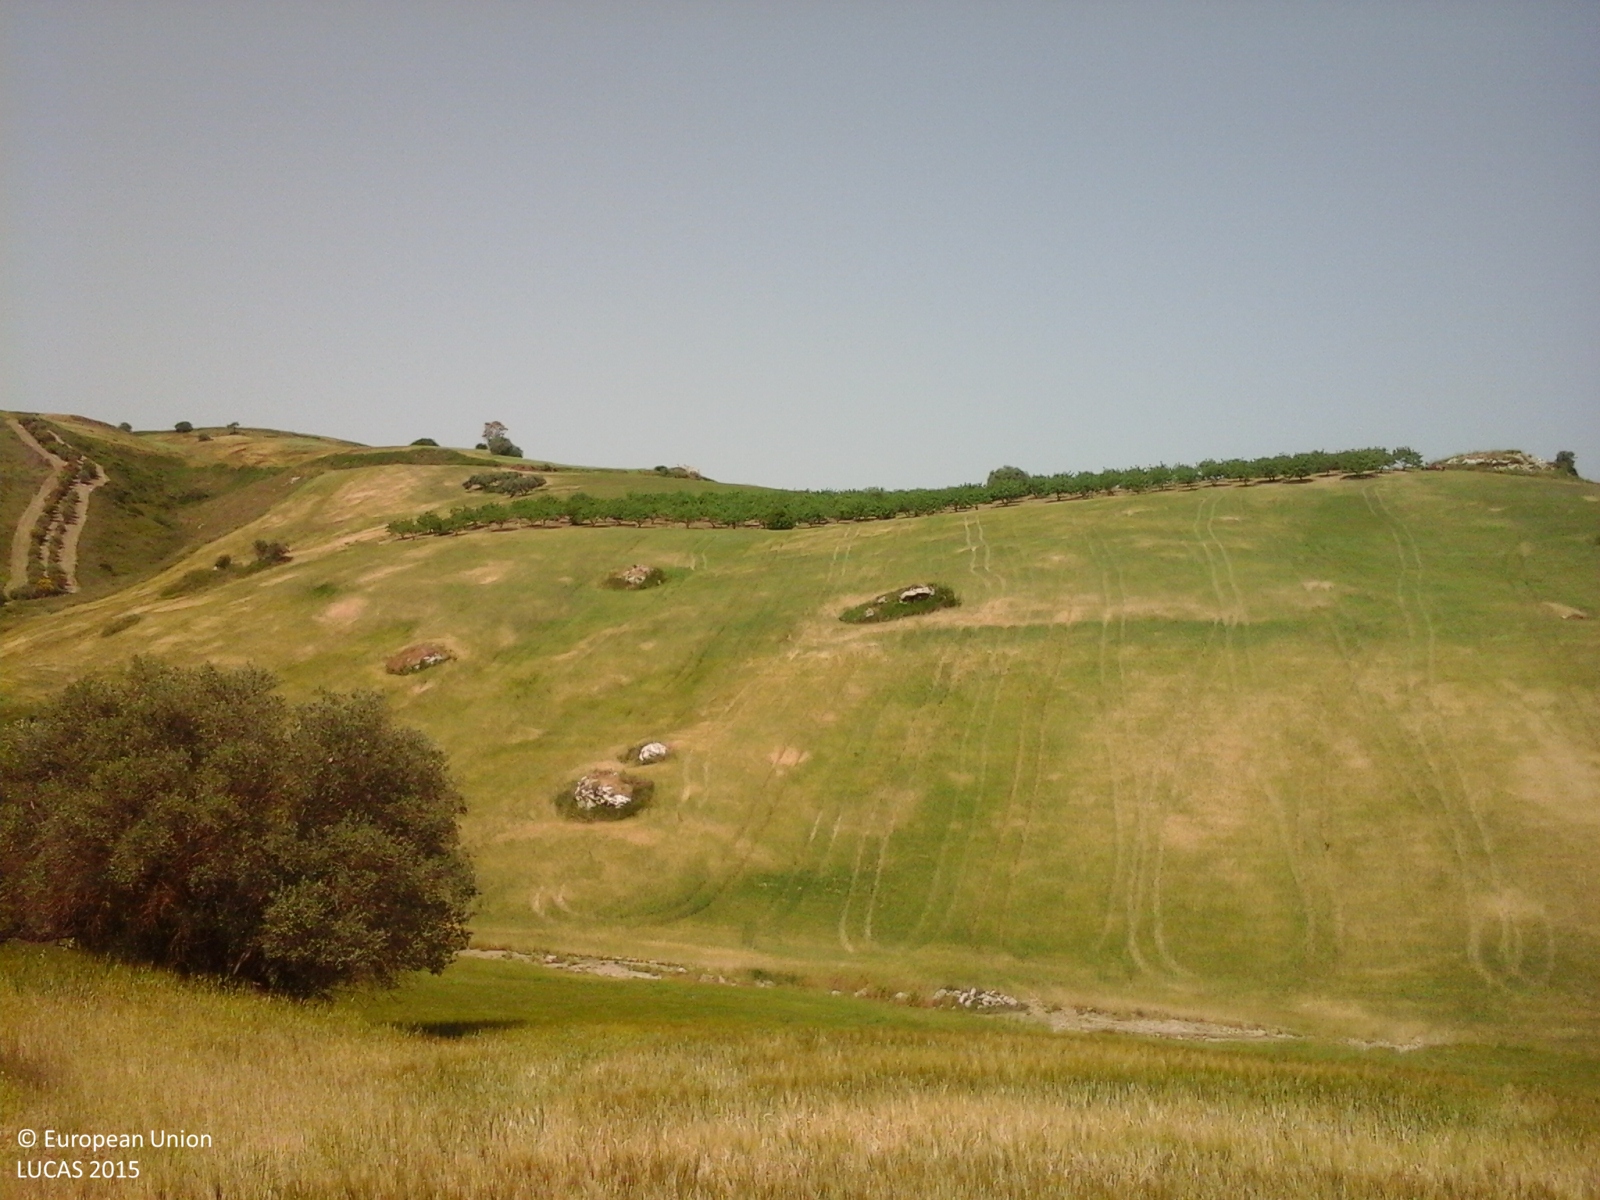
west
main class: Cropland
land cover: Durum wheat
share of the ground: > 75 %
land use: Agriculture (excluding fallow land and kitchen gardens)
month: May
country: IT
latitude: 37.5032
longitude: 13.9185
